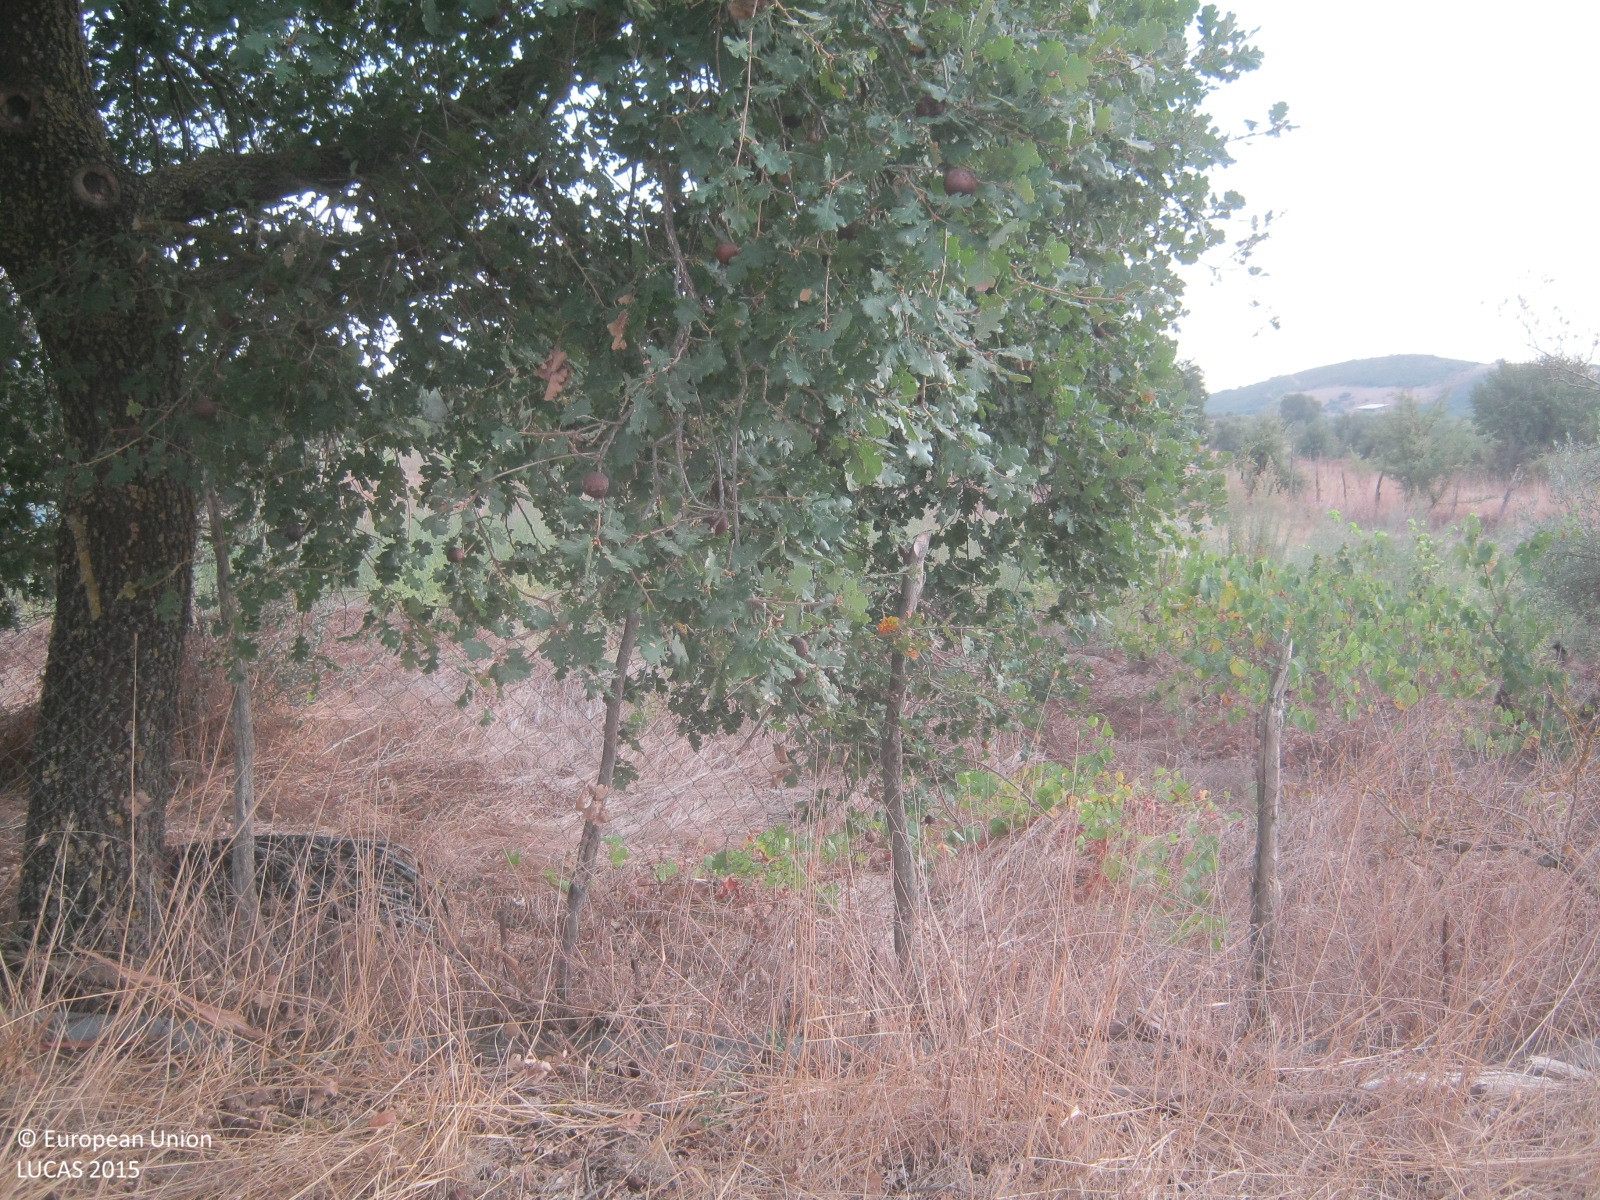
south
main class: Cropland
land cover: Maize
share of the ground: > 75 %
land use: Agriculture (excluding fallow land and kitchen gardens)
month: September
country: GR
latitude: 37.9647
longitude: 21.6304
